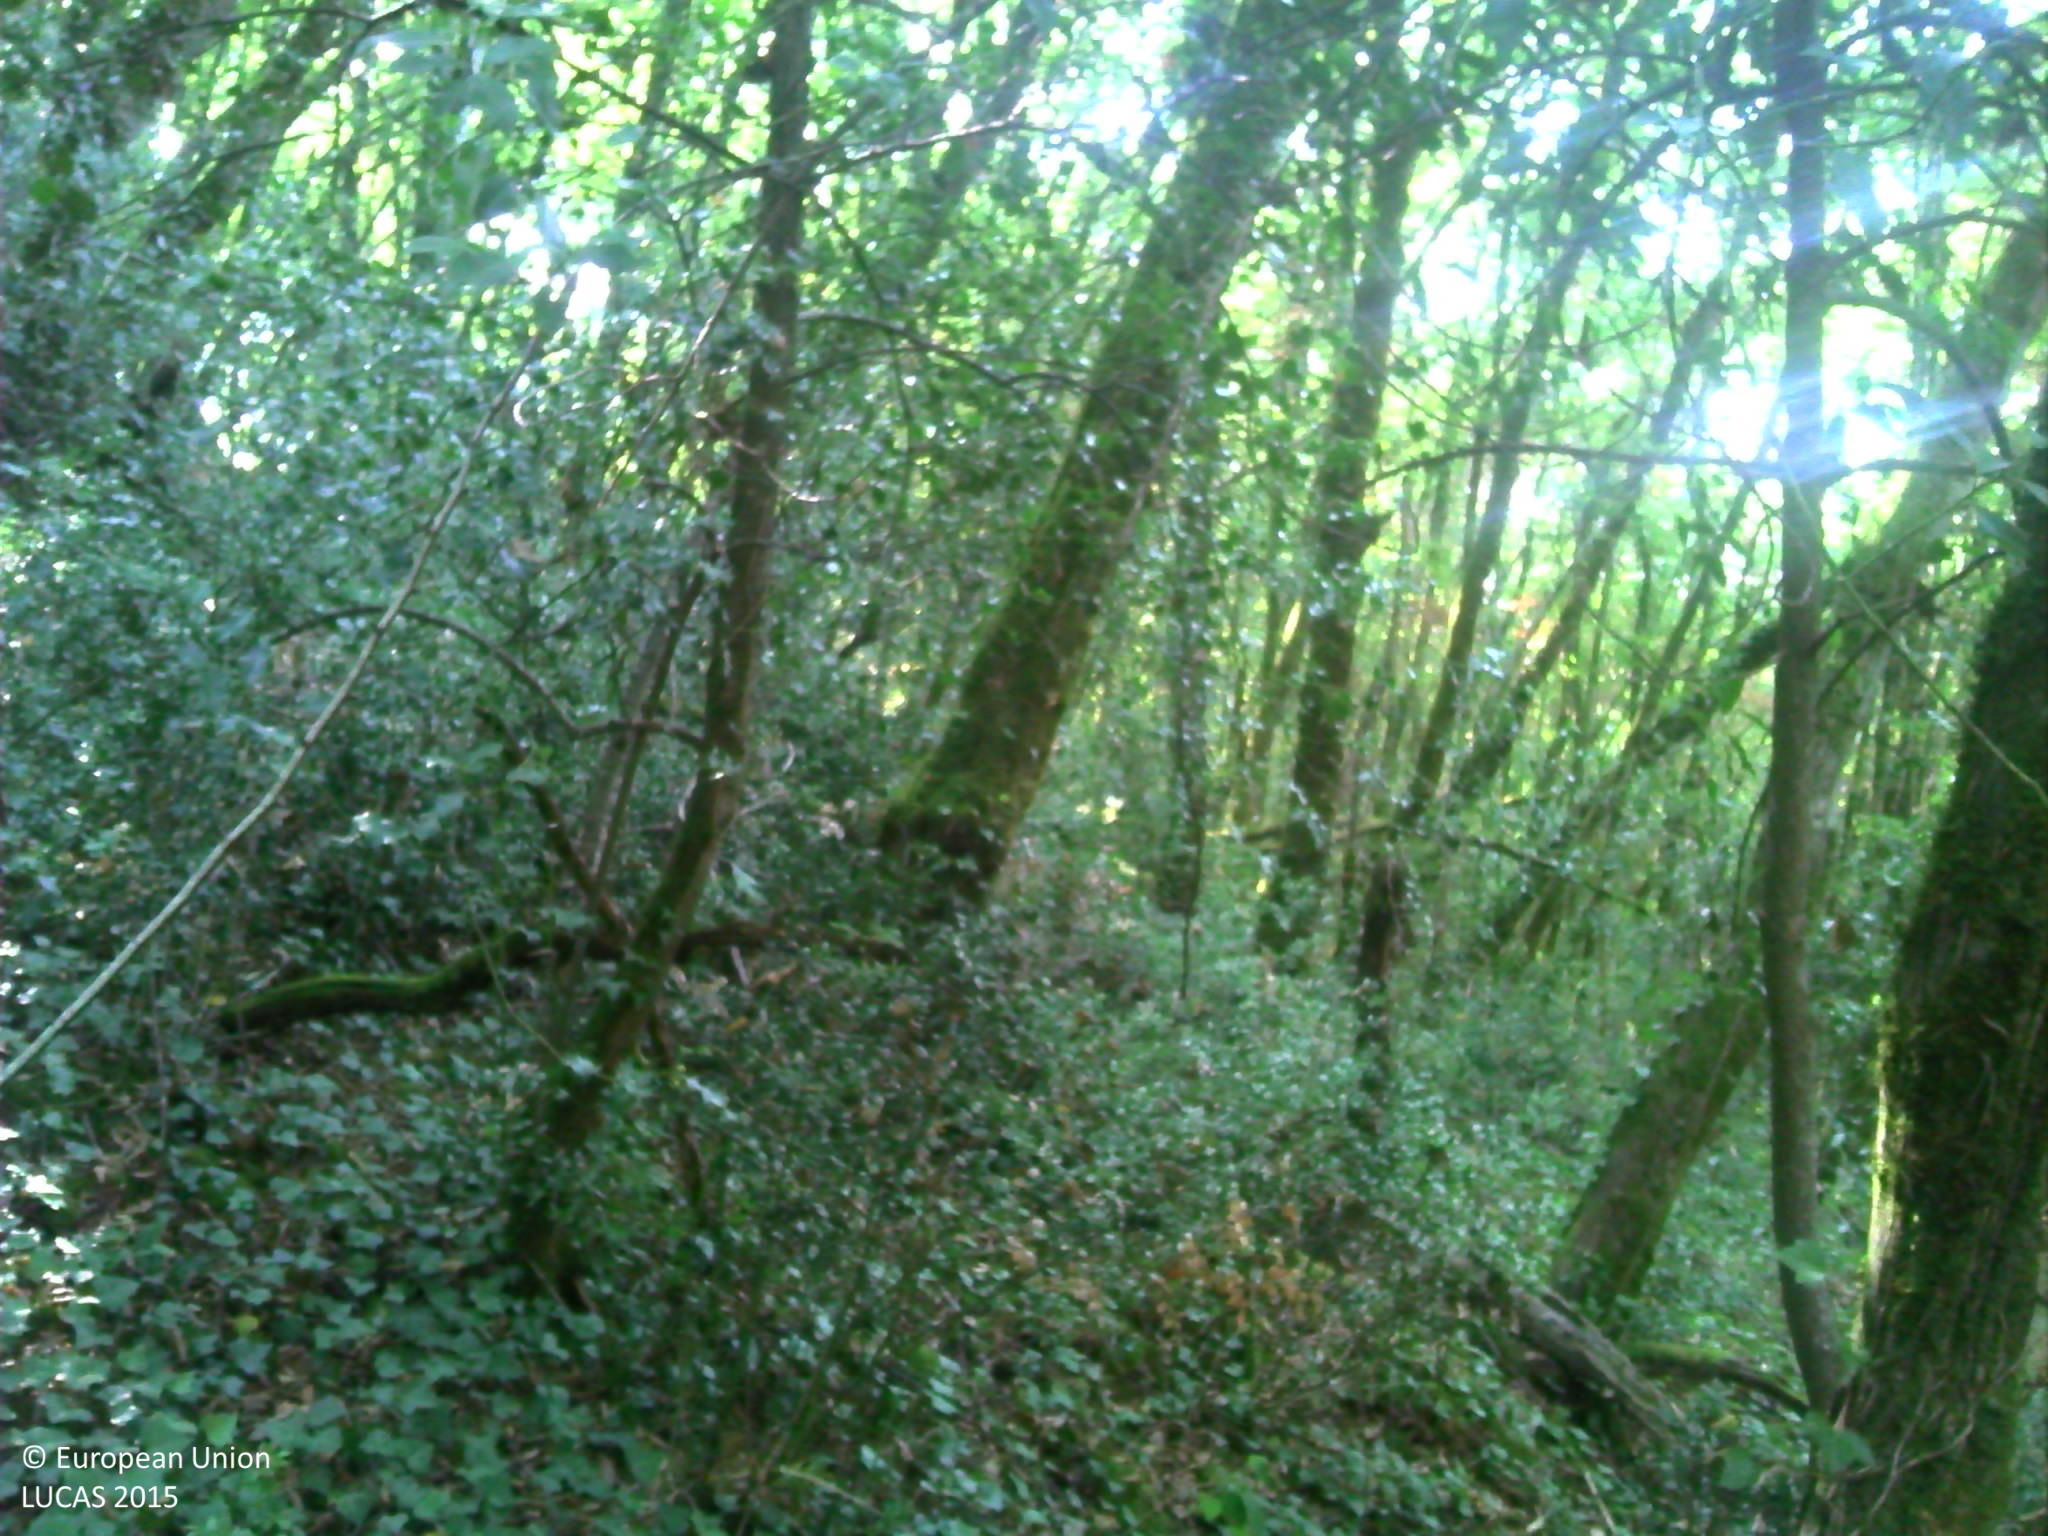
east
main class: Woodland
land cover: Broadleaved woodland
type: mesophytic deciduous forest
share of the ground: 50 - 75 %
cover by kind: broadleaved forest trees 80 %, herbaceous plants 20 %
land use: Forestry
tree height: > 5 m
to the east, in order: Broadleaved woodland; Spruce dominated mixed woodland
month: August
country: FR
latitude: 45.3690
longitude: 1.8372
